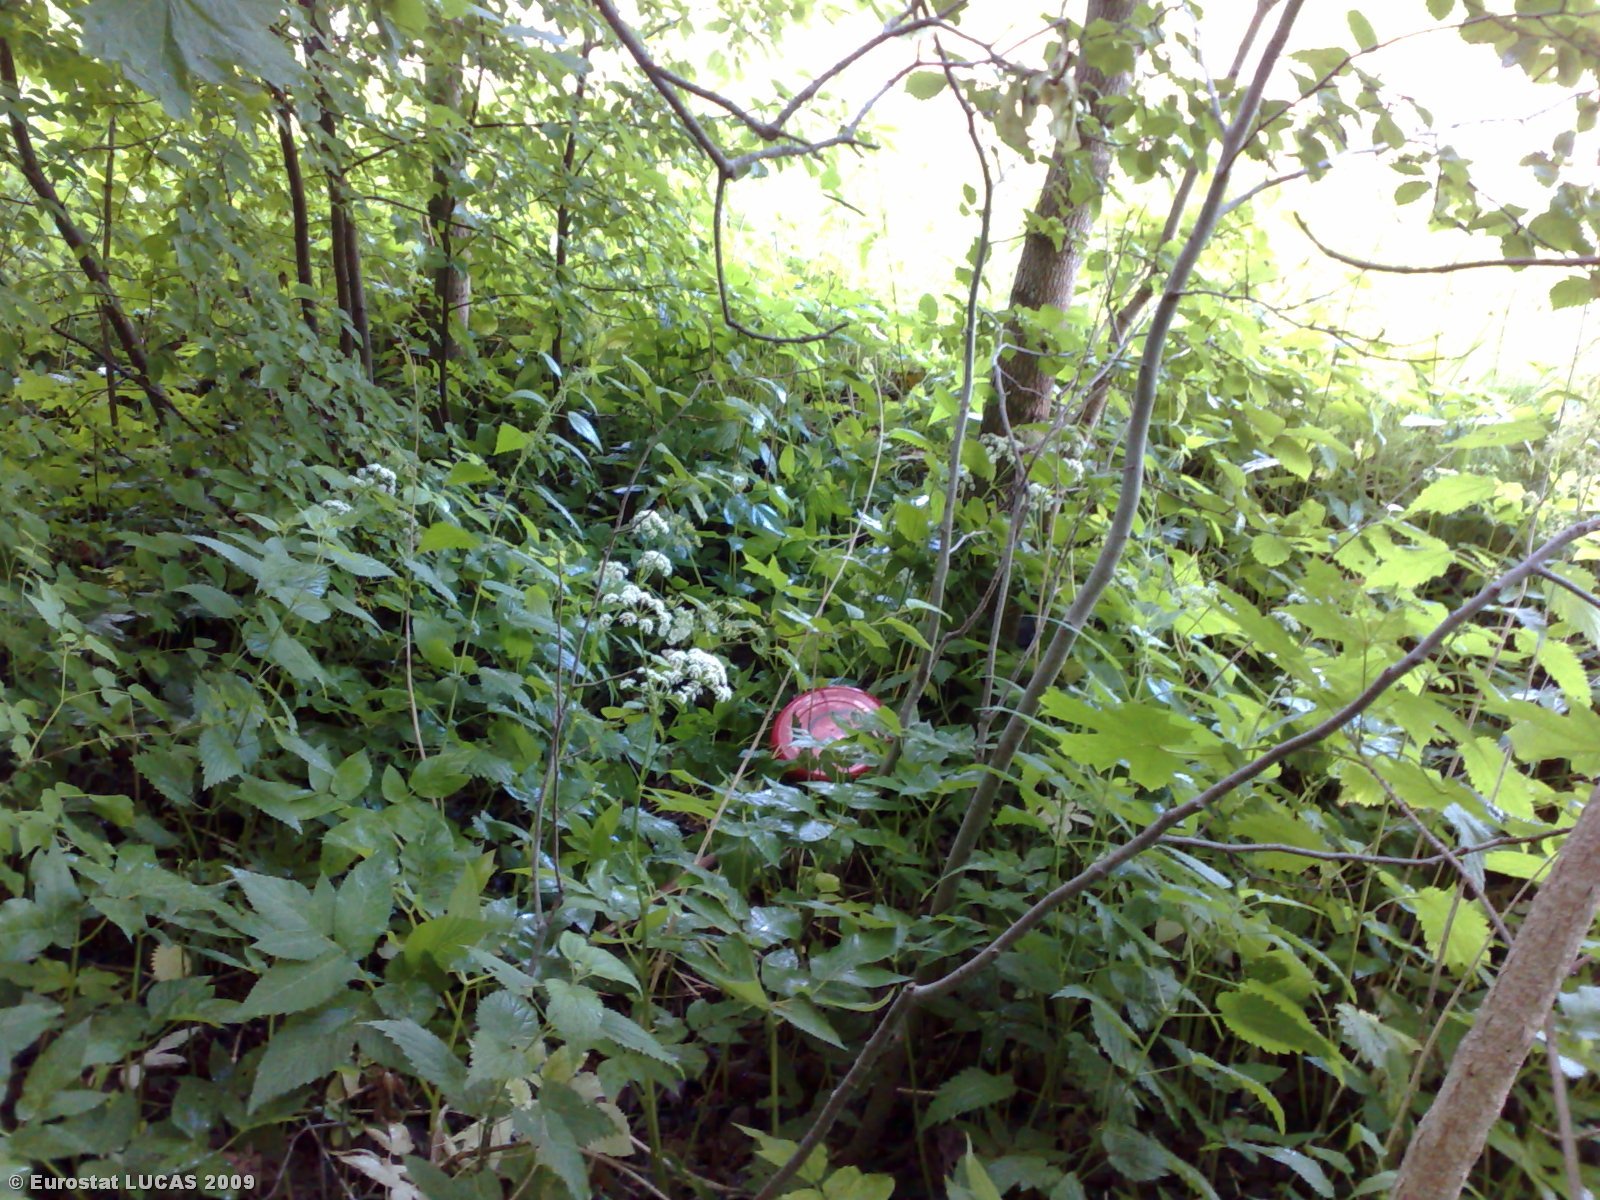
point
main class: Woodland
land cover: Broadleaved woodland
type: non-riverine alder, birch or aspen forest
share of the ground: > 75 %
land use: Forestry
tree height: > 5 m
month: July
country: LT
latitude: 55.6563
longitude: 22.7641
